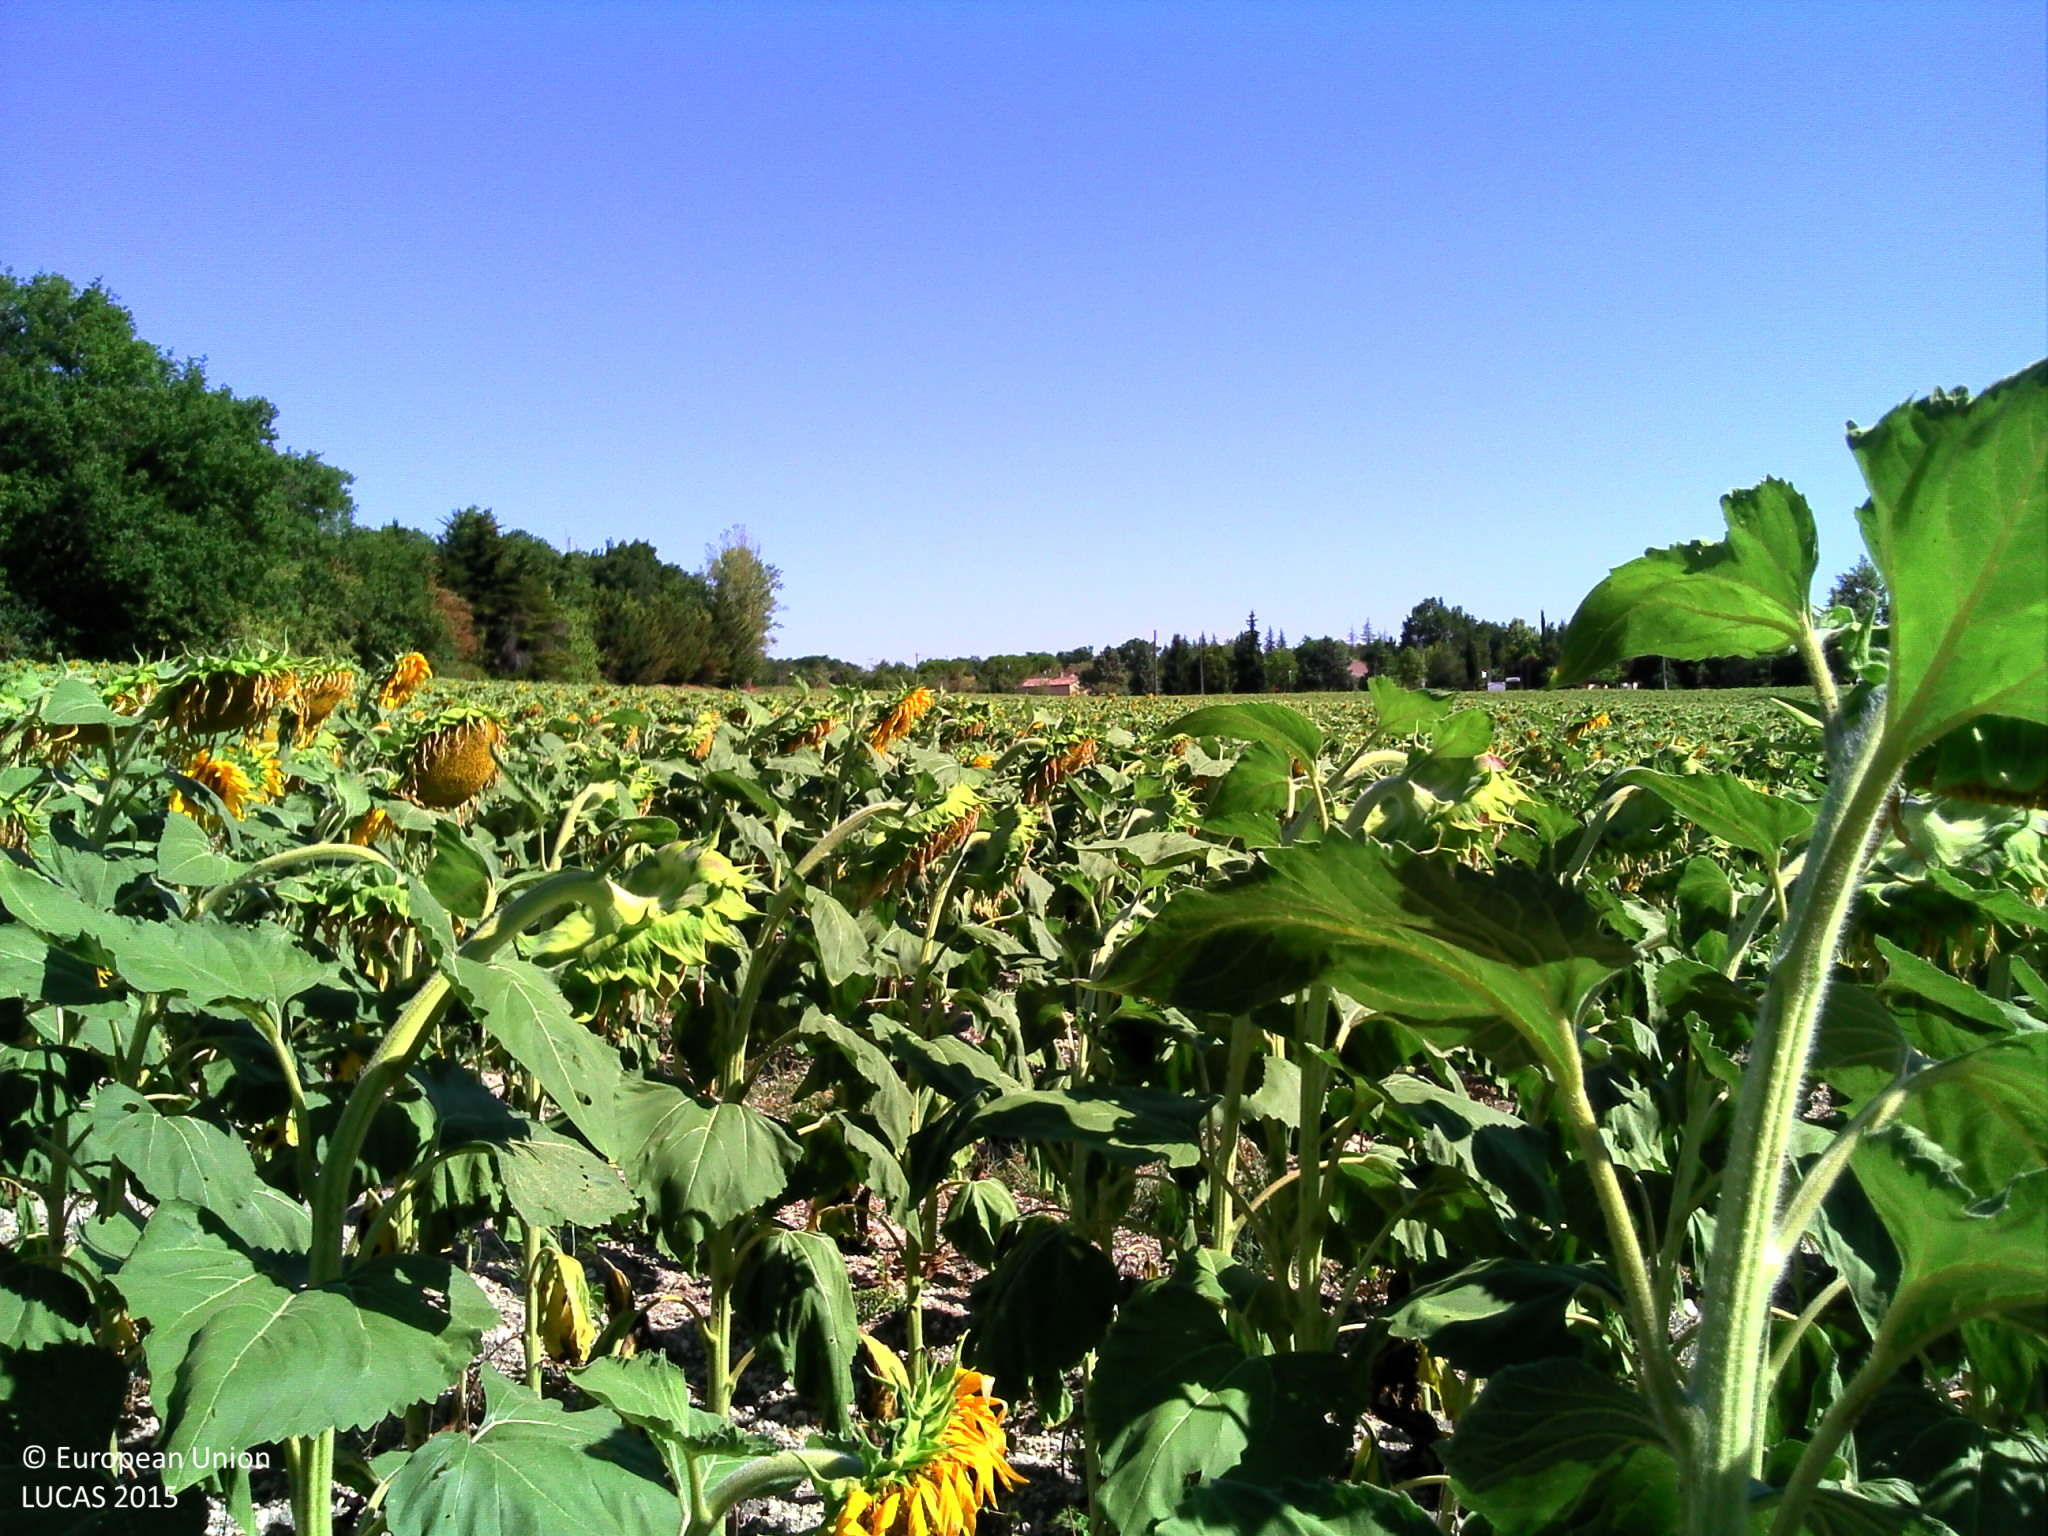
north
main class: Cropland
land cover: Sunflower
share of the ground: 50 - 75 %
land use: Agriculture (excluding fallow land and kitchen gardens)
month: July
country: FR
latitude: 44.7514
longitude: 0.5301
